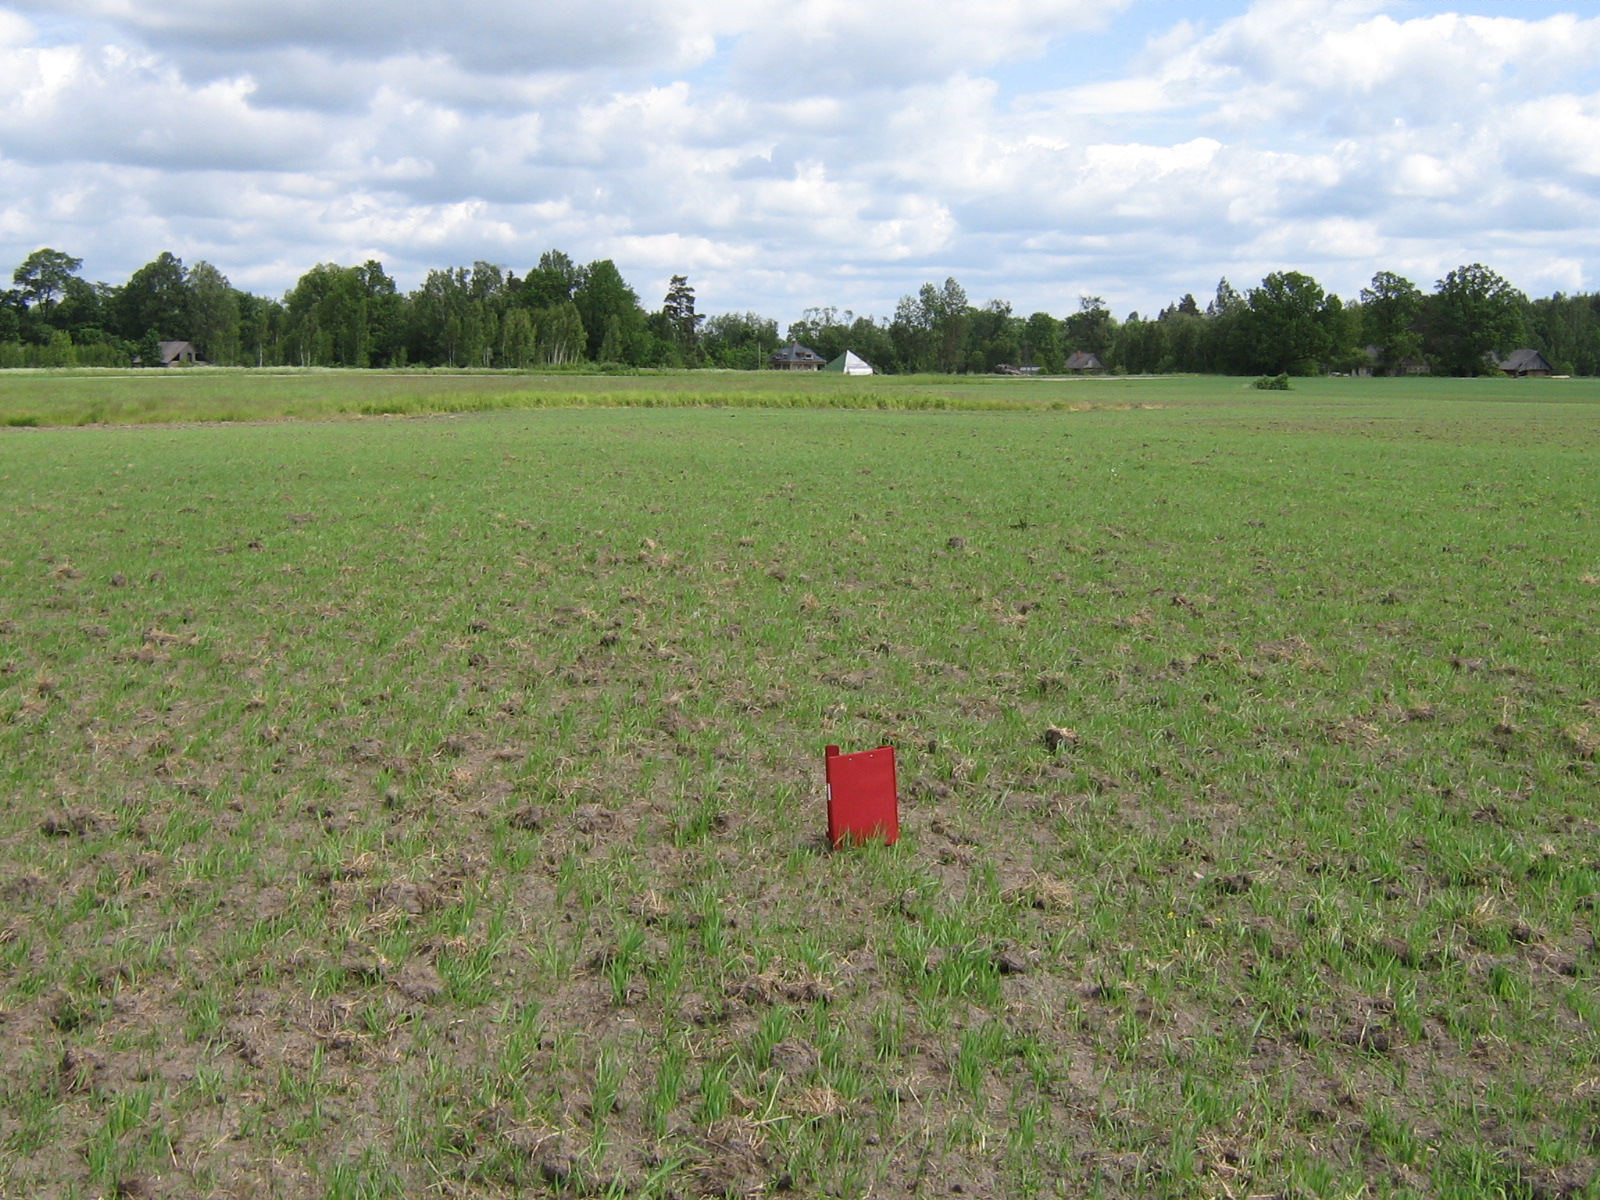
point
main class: Cropland
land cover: Rye
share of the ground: 50 - 75 %
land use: Agriculture (excluding fallow land and kitchen gardens)
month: June
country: LV
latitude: 56.6683
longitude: 25.5071
